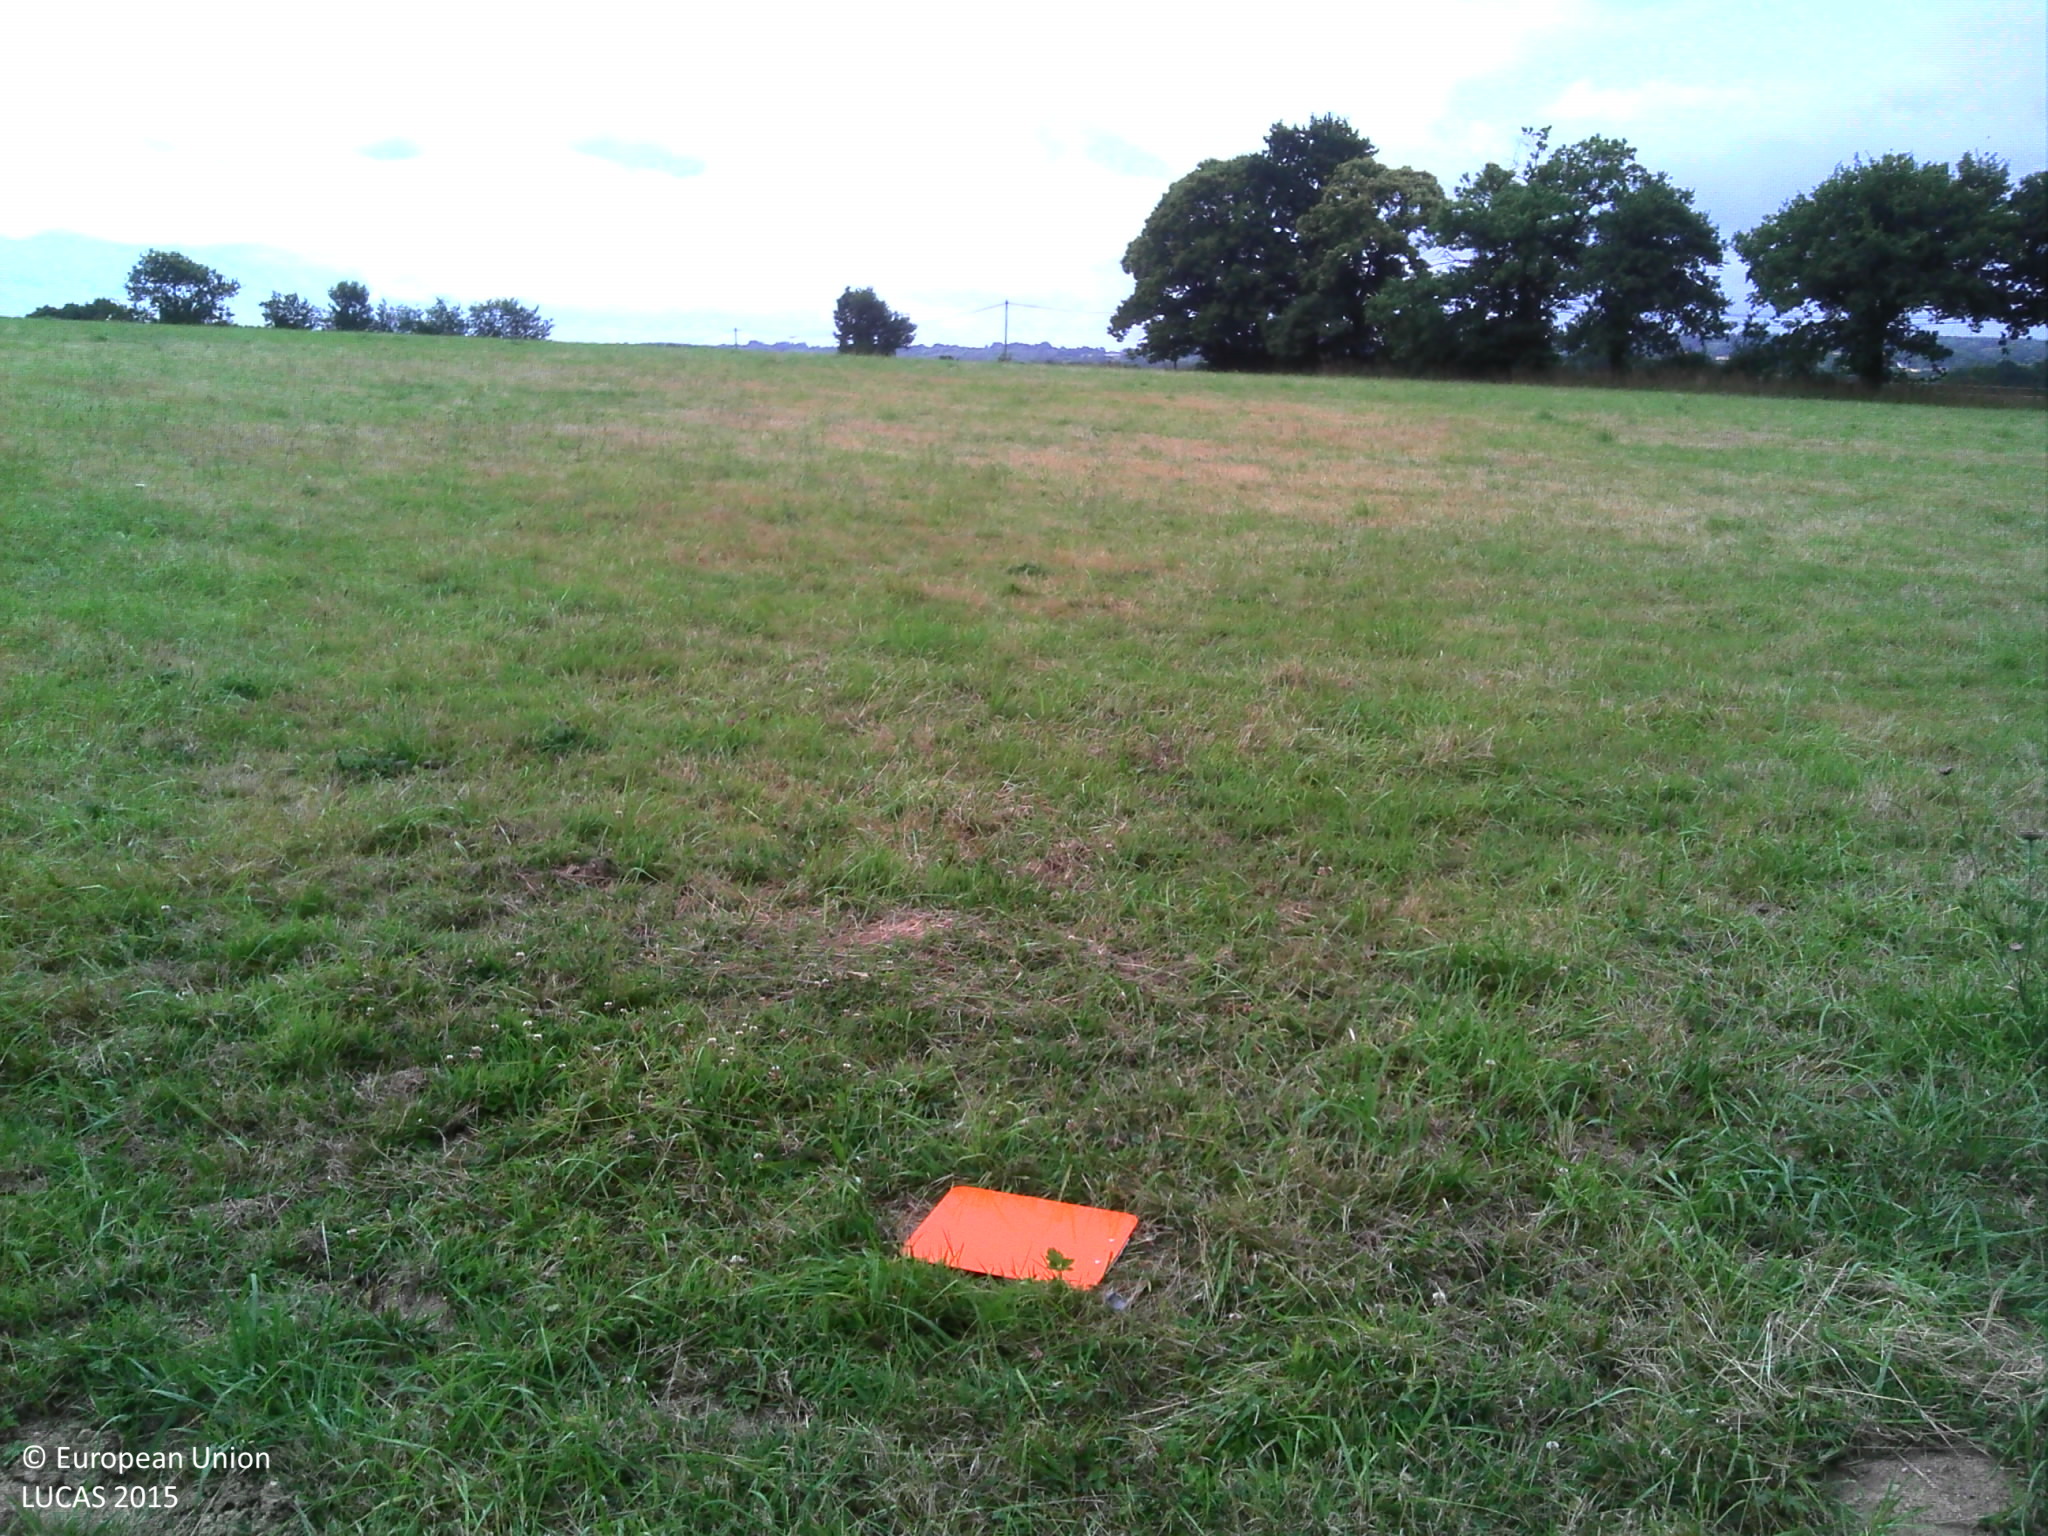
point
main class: Grassland
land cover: Grassland without tree/shrub cover
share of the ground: > 75 %
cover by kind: herbaceous plants 100 %
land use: Agriculture (excluding fallow land and kitchen gardens)
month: July
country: FR
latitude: 47.5654
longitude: -1.9991
